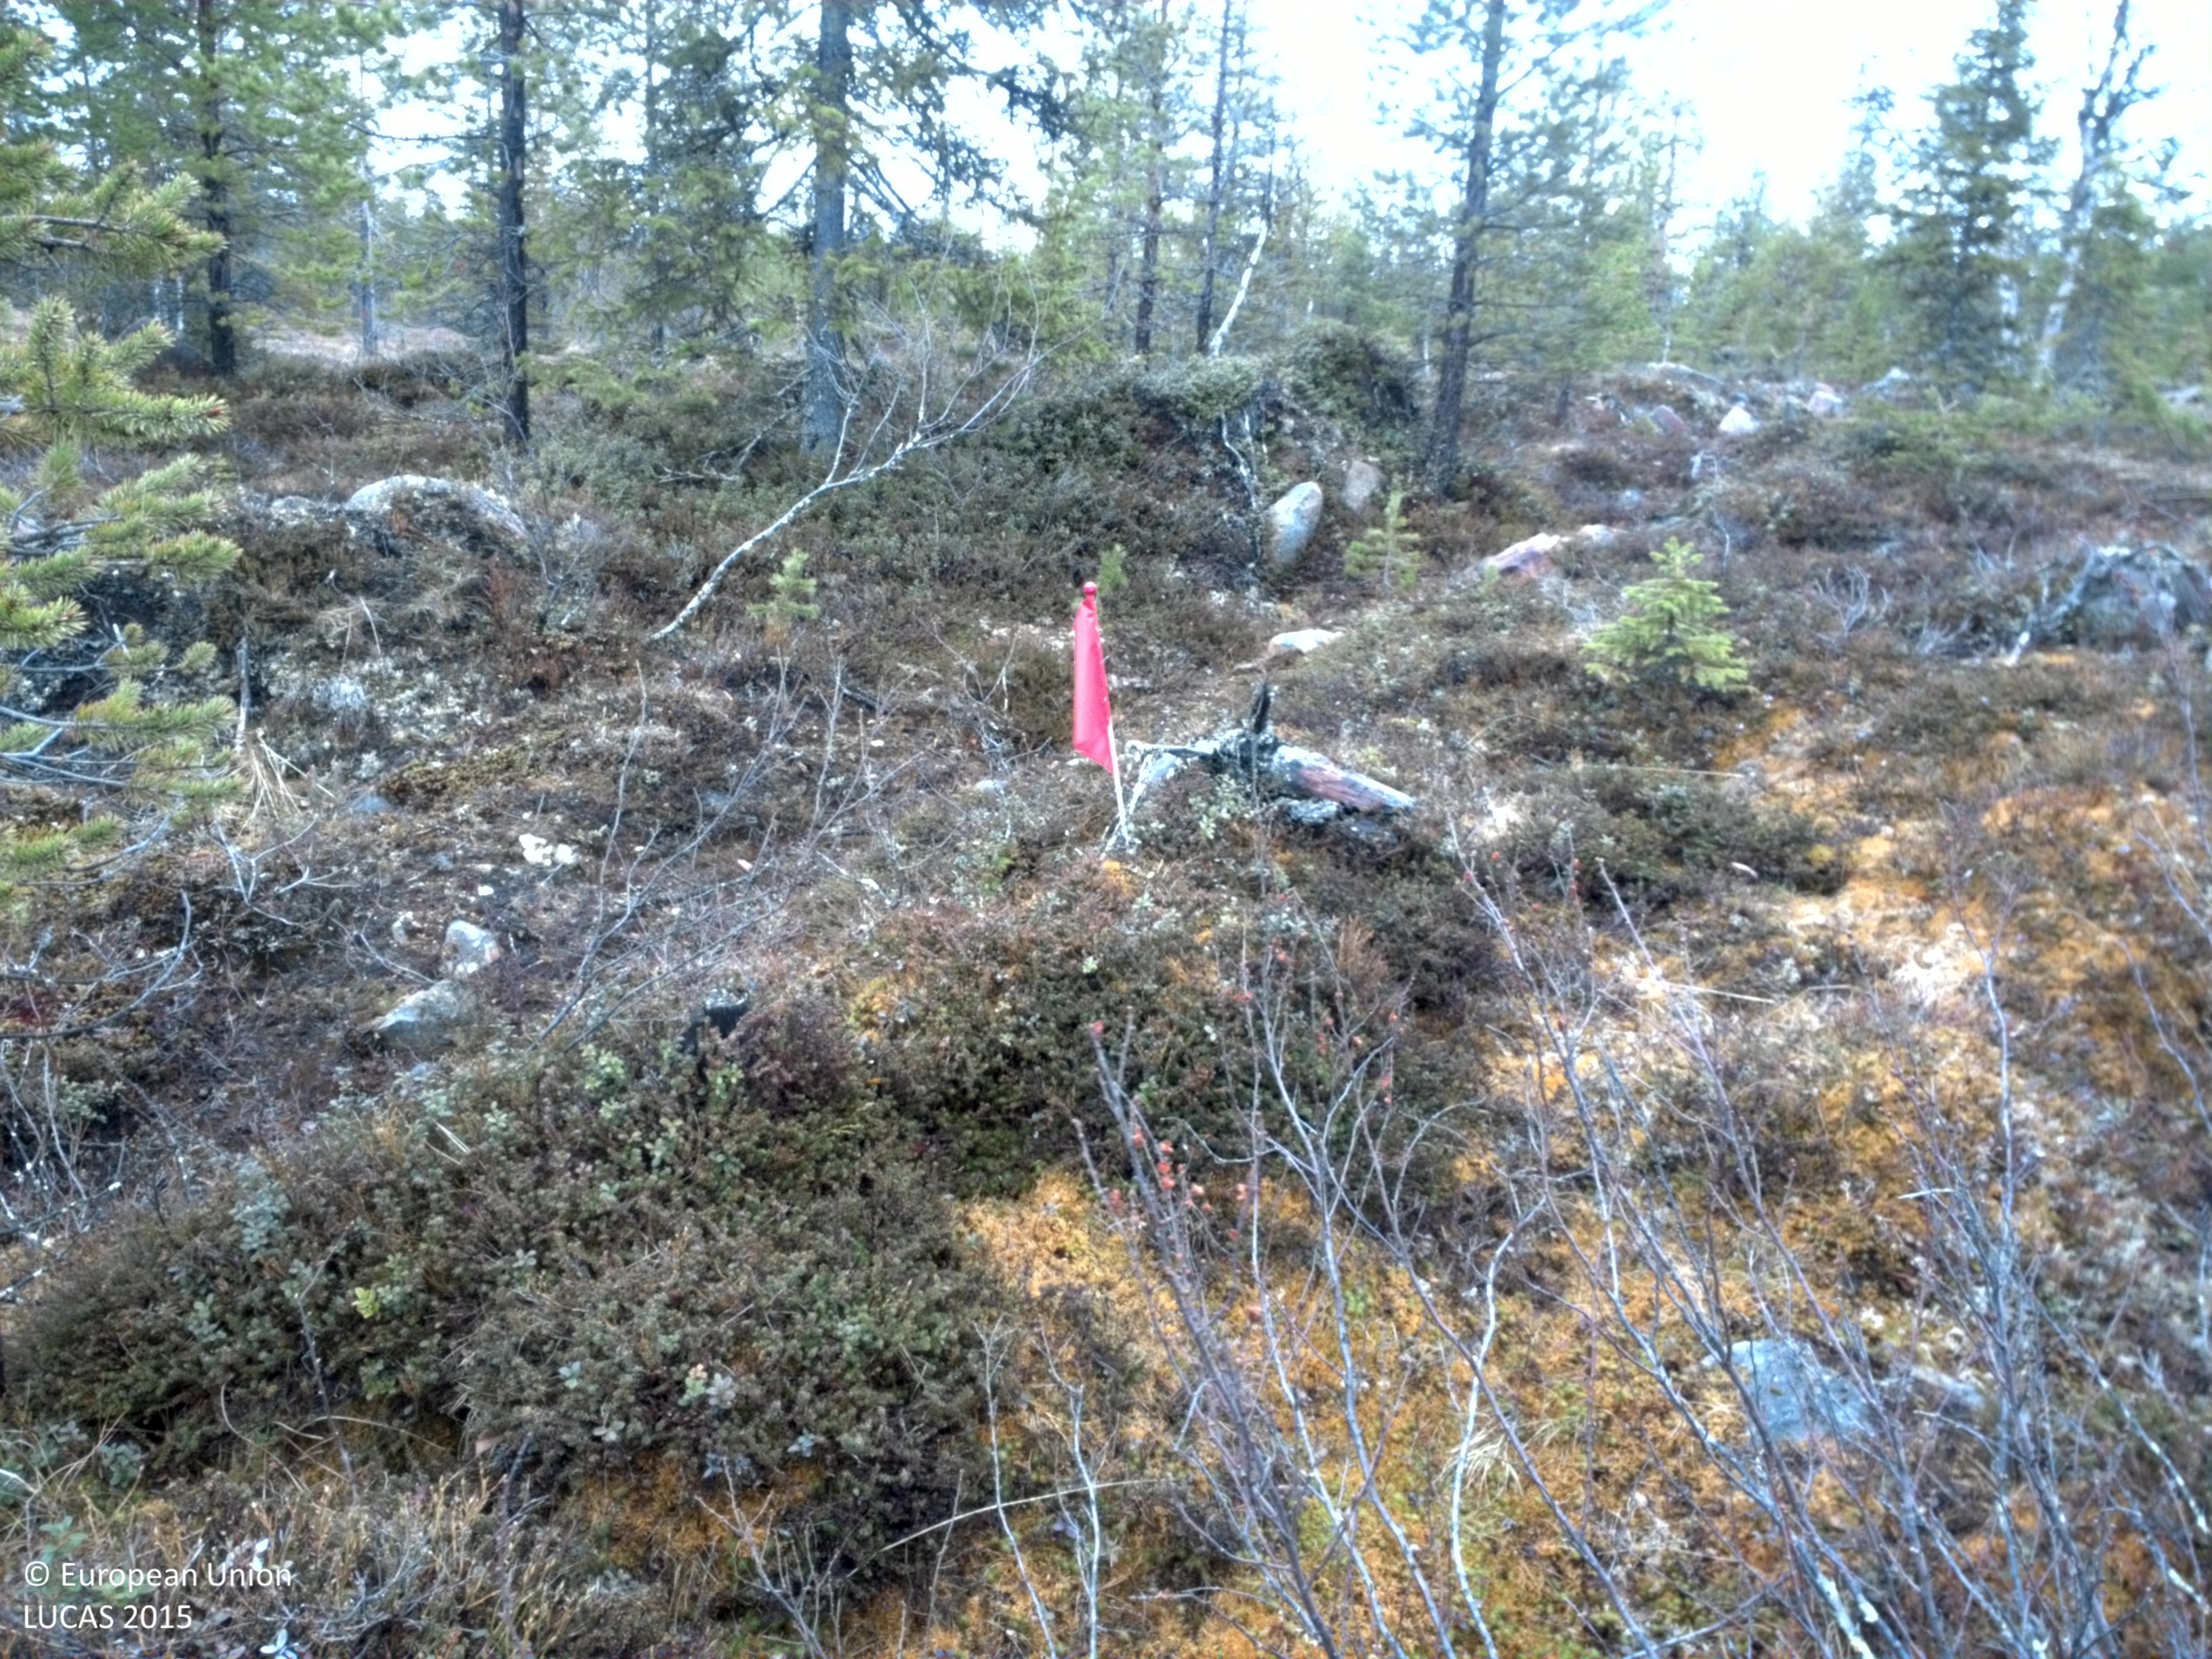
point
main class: Woodland
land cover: Pine dominated coniferous woodland
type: boreal forest
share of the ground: 25 - 50 %
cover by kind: lichens and mosses 55 %, coniferous forest trees 35 %, broadleaved forest trees 5 %, shrubs 5 %
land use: Forestry
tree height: > 5 m
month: June
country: SE
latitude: 66.9557
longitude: 20.7807
